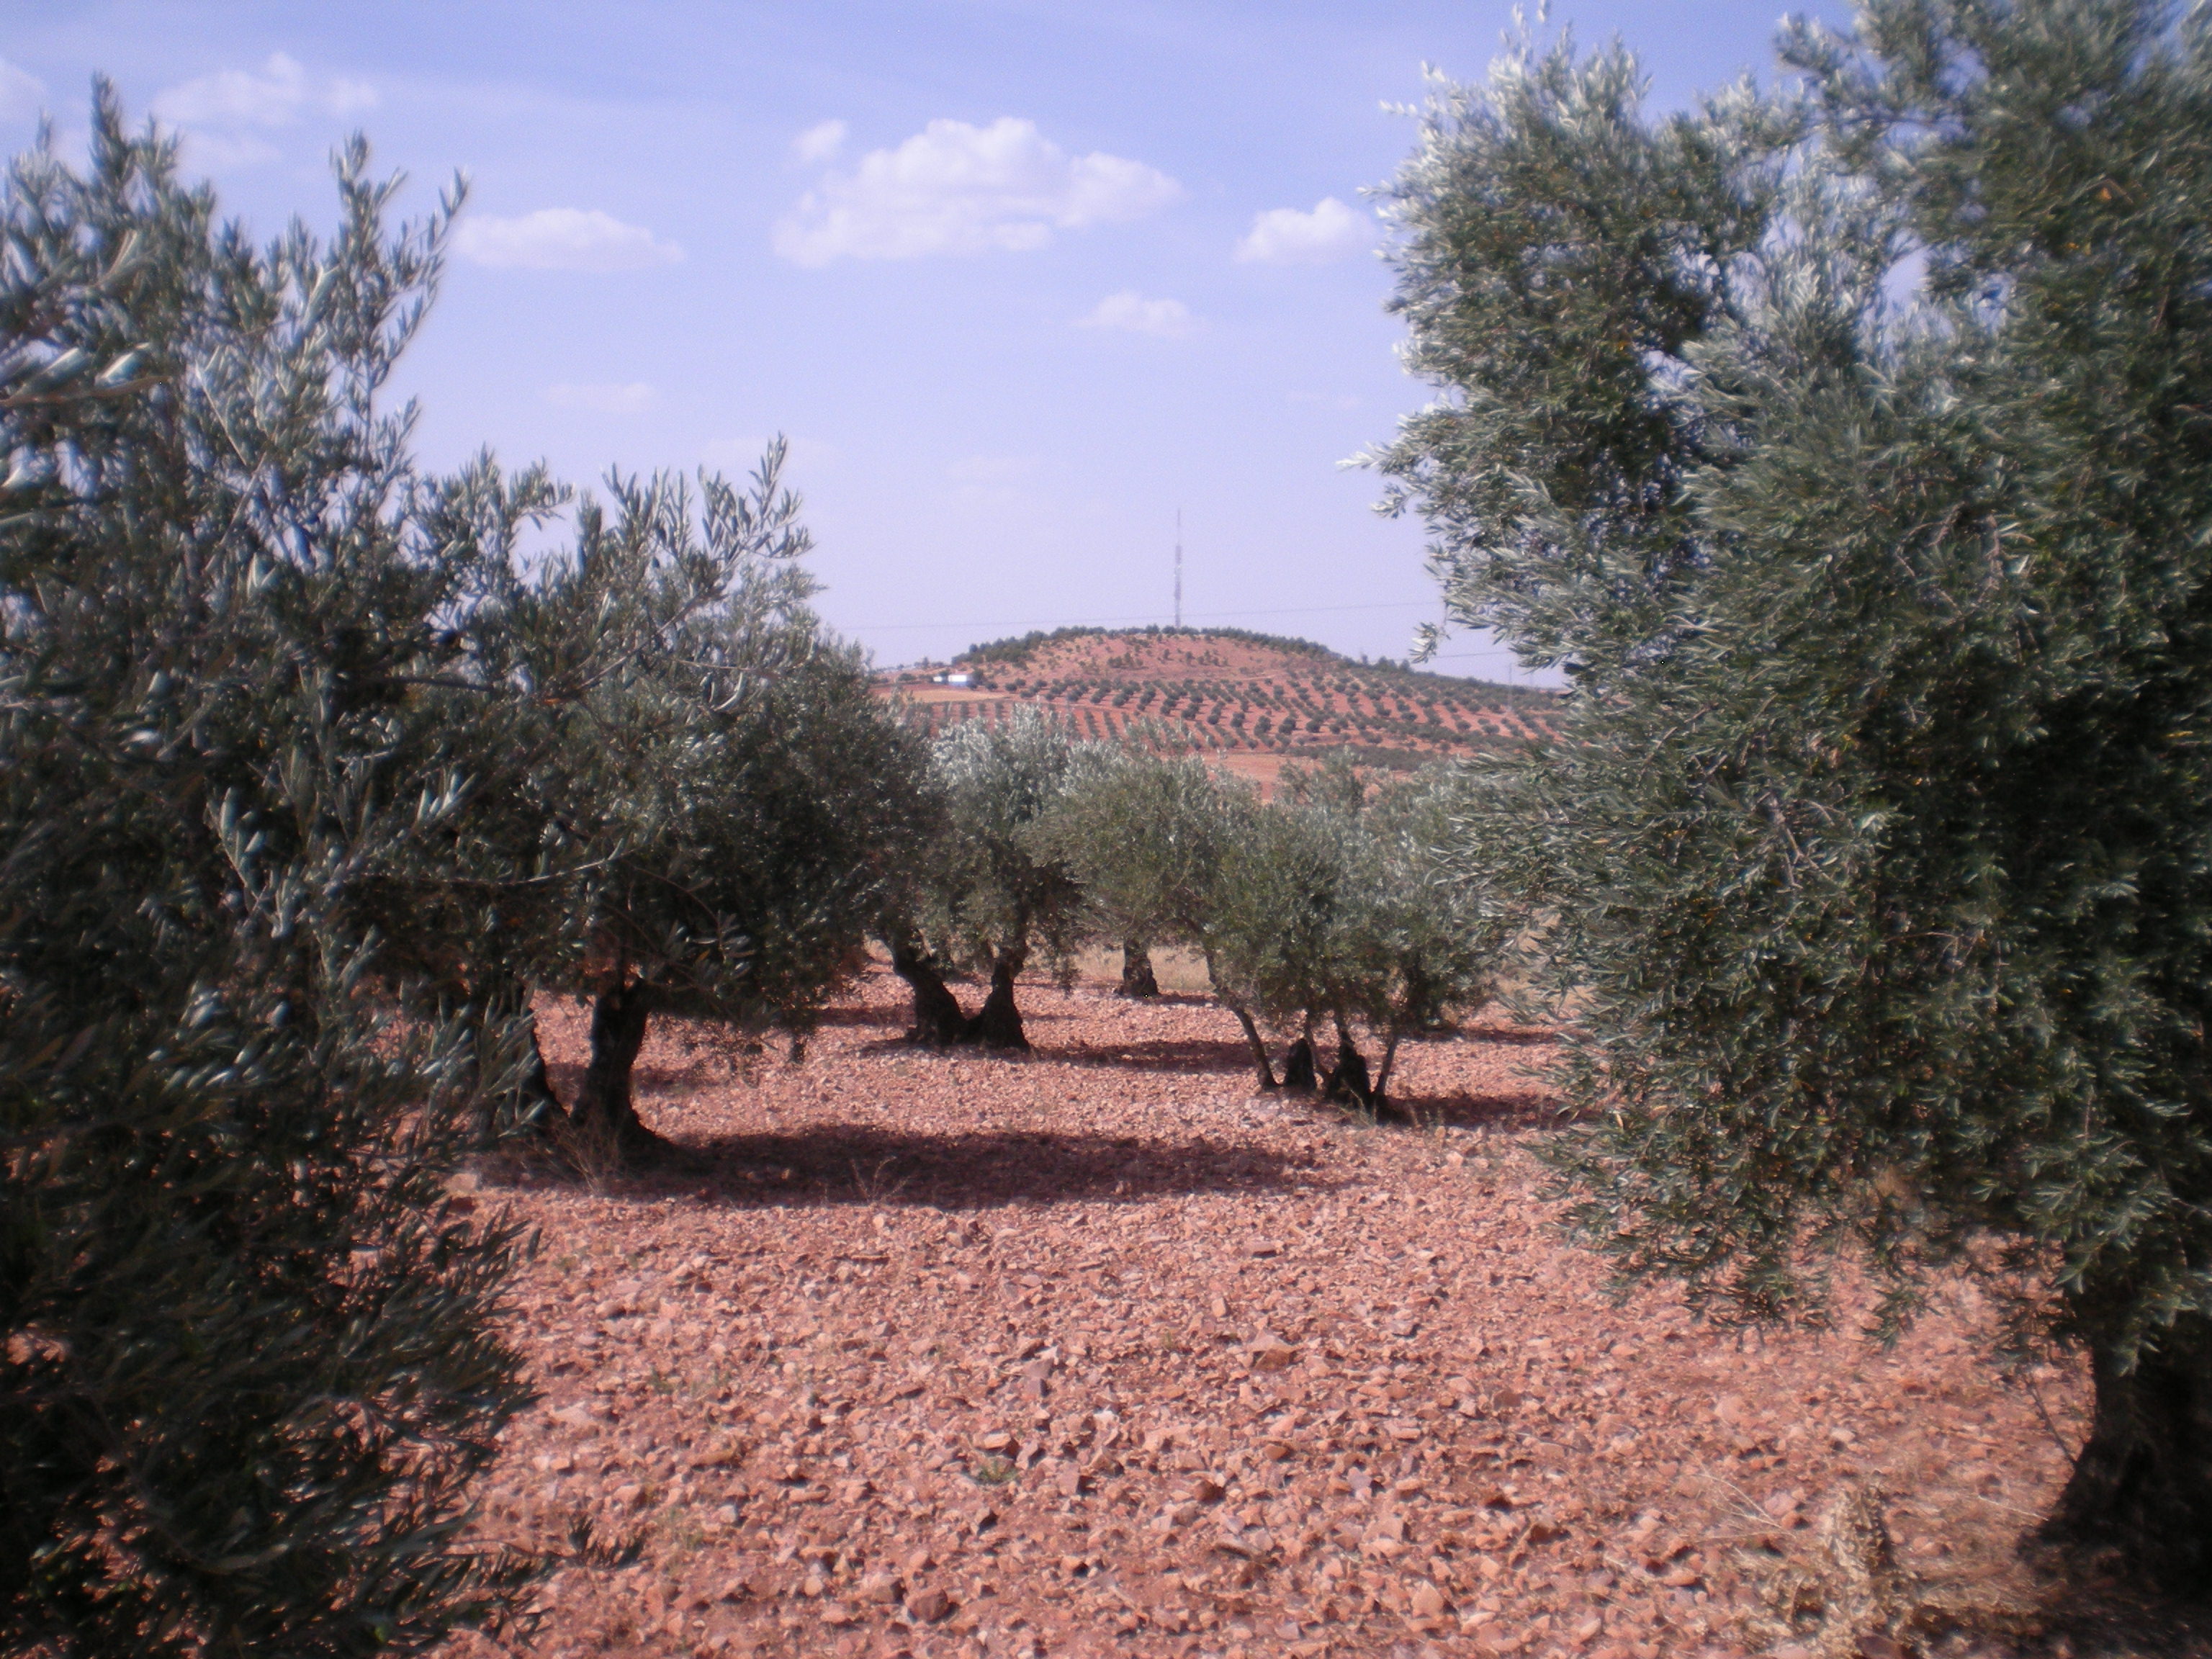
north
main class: Cropland
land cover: Olive groves
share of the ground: 25 - 50 %
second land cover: Other bare soil
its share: > 75 %
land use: Agriculture (excluding fallow land and kitchen gardens)
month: July
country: ES
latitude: 39.3722
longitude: -3.1922
